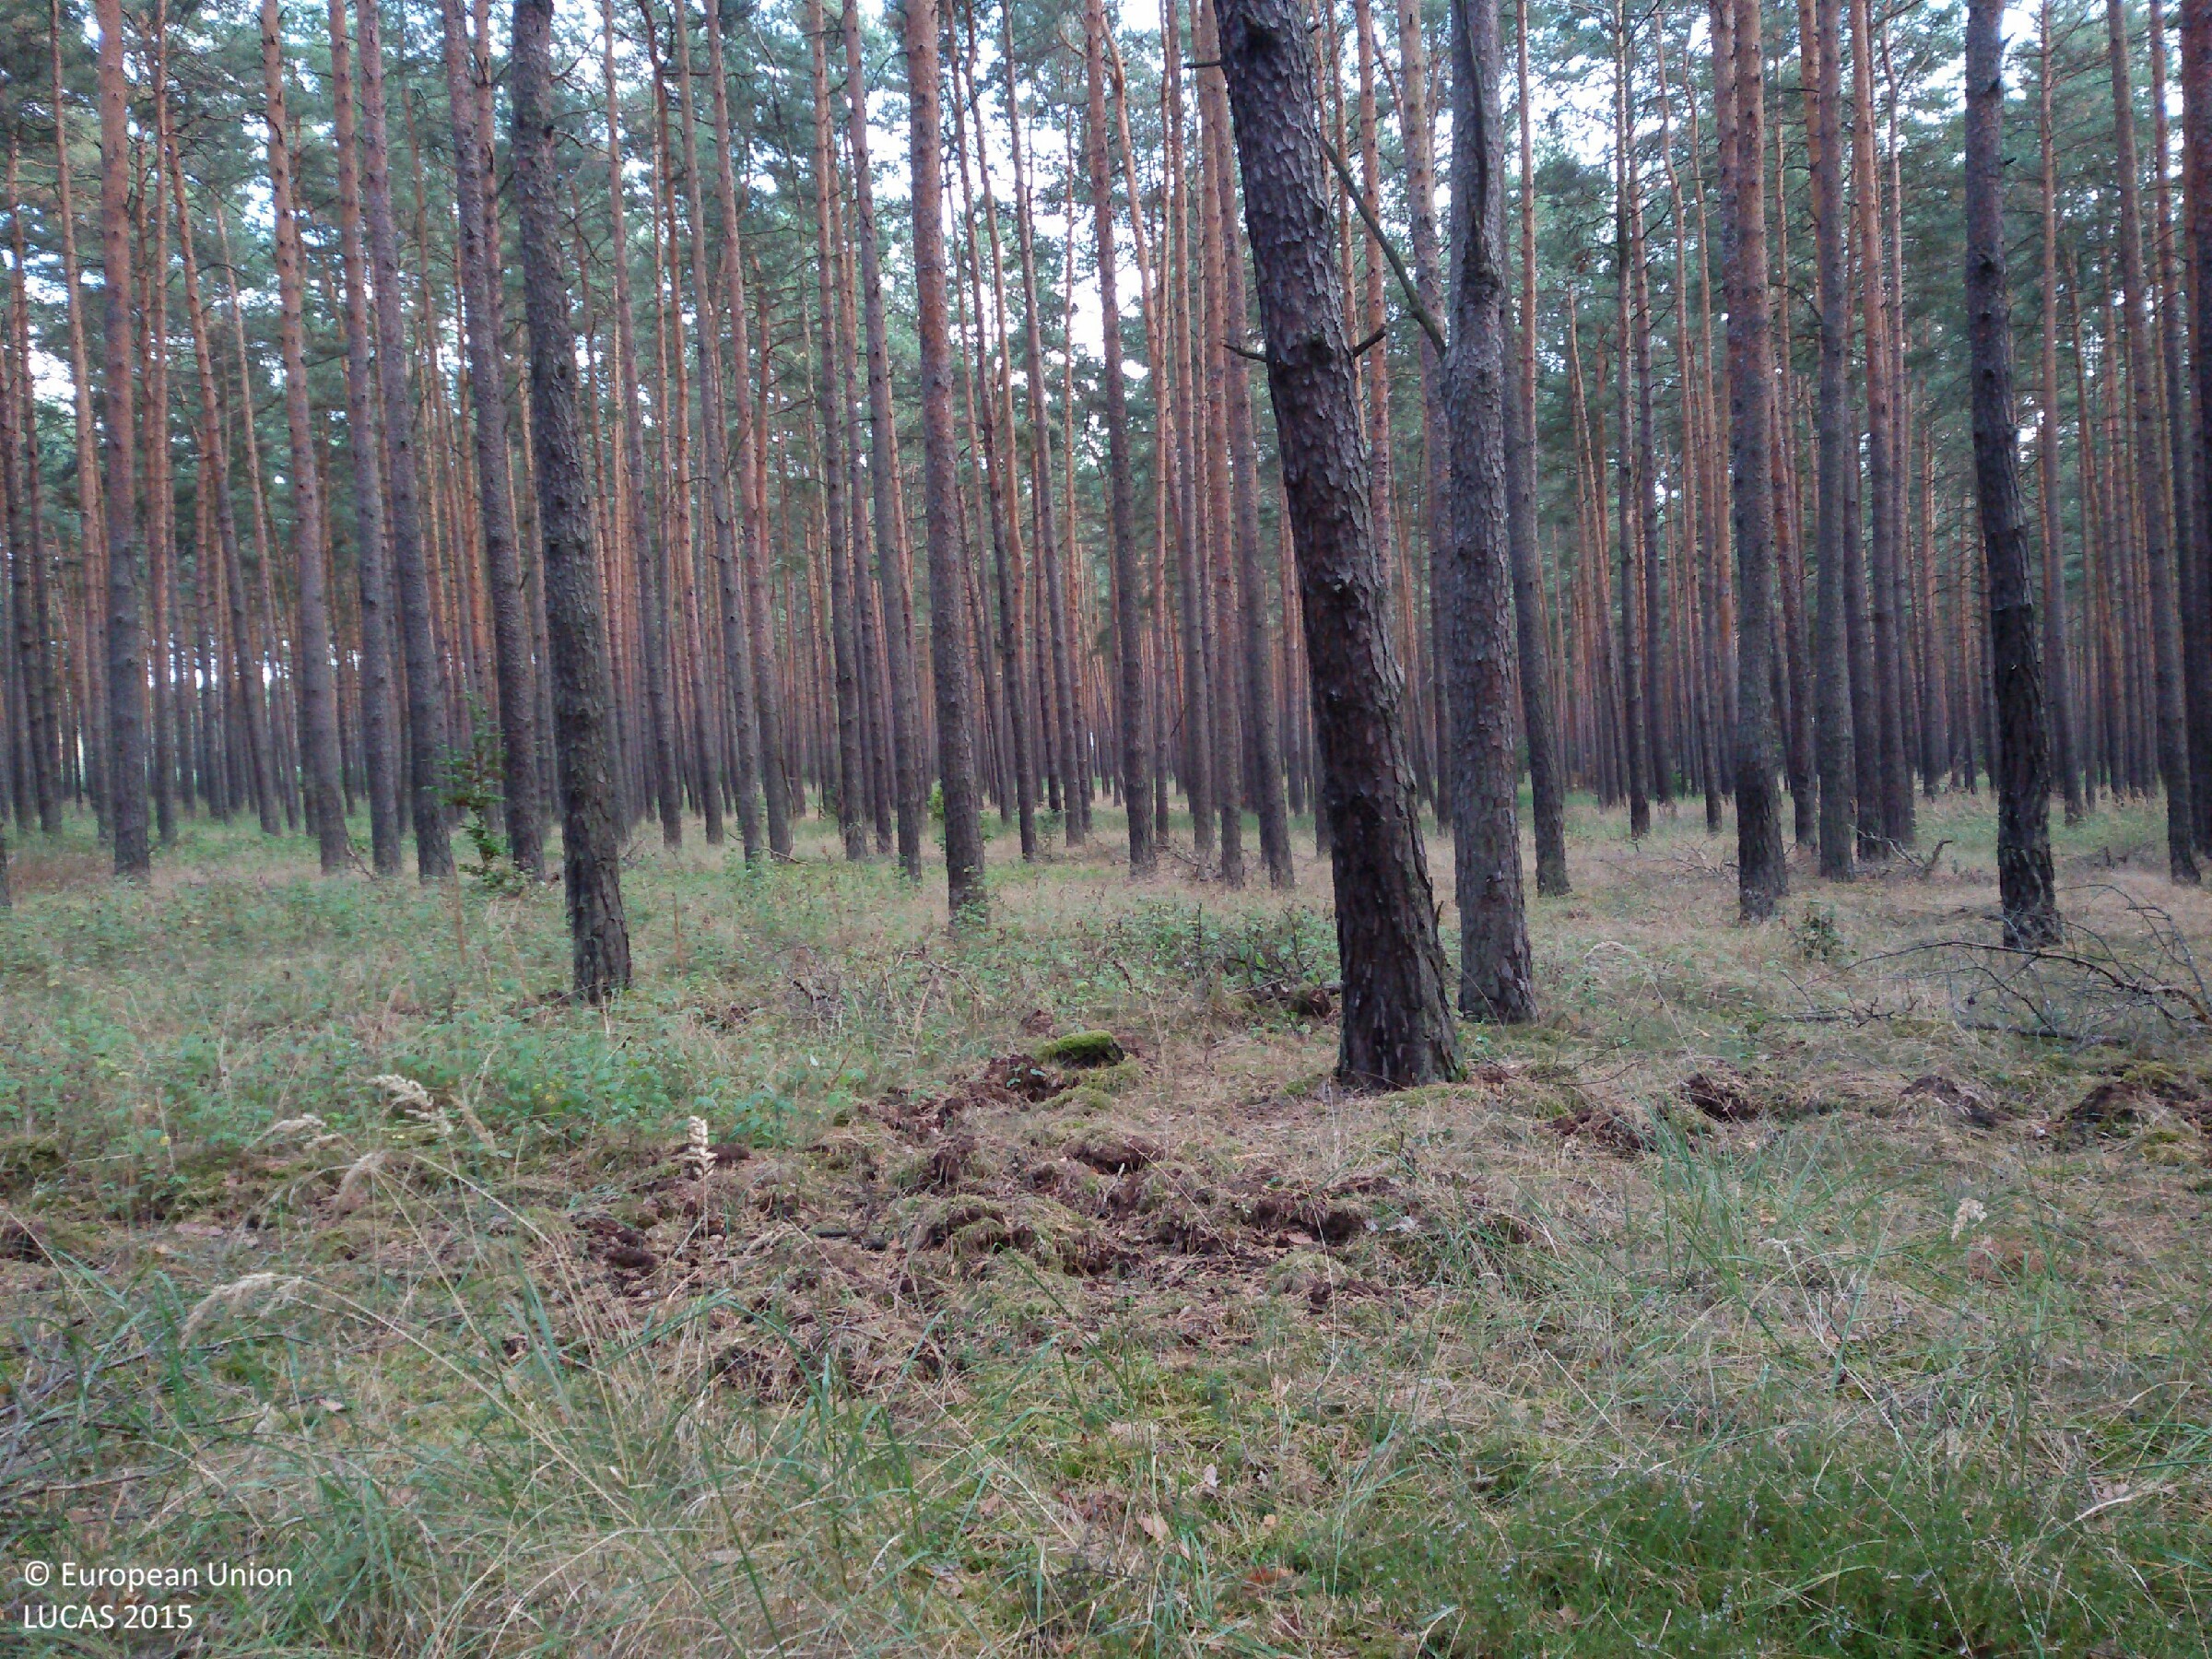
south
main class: Woodland
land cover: Pine dominated coniferous woodland
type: hemiboreal forest and nemoral coniferous forest and mixed broadleaved-coniferous forest
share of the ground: > 75 %
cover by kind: coniferous forest trees 85 %, herbaceous plants 15 %
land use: Forestry
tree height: > 5 m
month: September
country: PL
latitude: 52.2651
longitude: 14.7349
